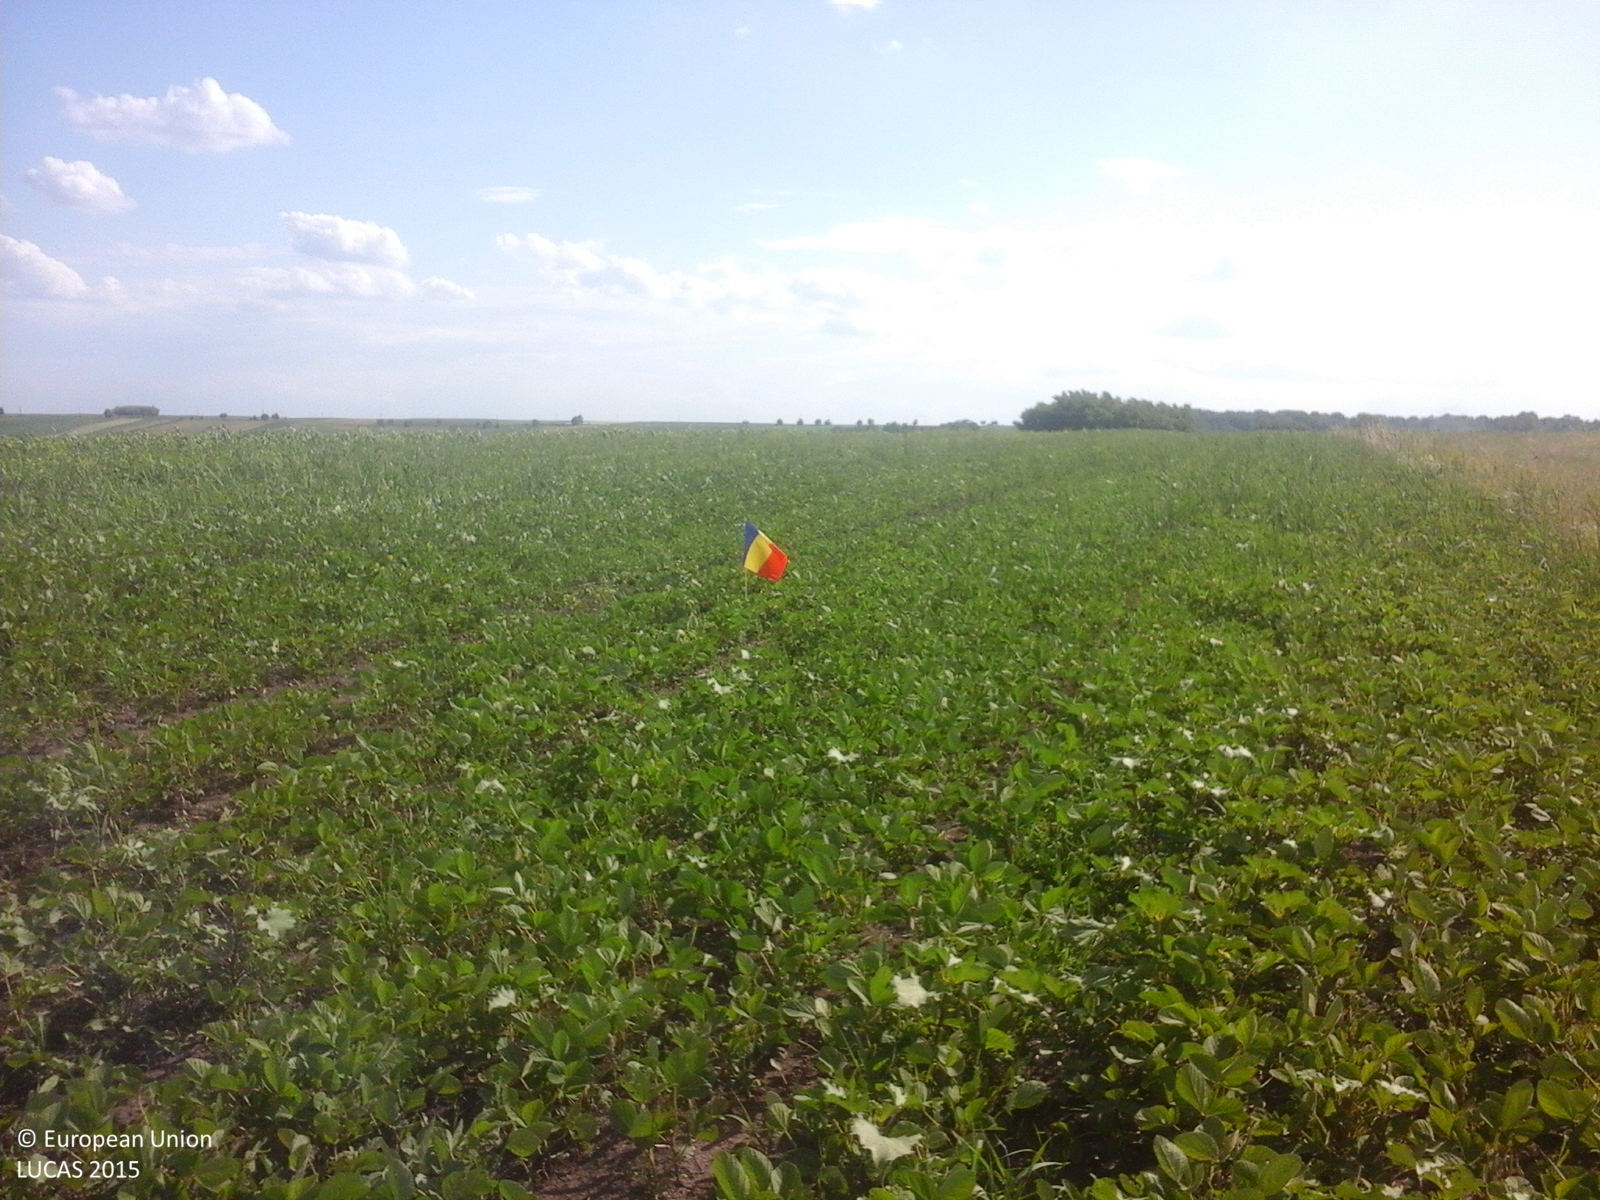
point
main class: Cropland
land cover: Soya
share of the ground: > 75 %
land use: Agriculture (excluding fallow land and kitchen gardens)
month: June
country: RO
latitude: 48.2069
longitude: 26.6903
